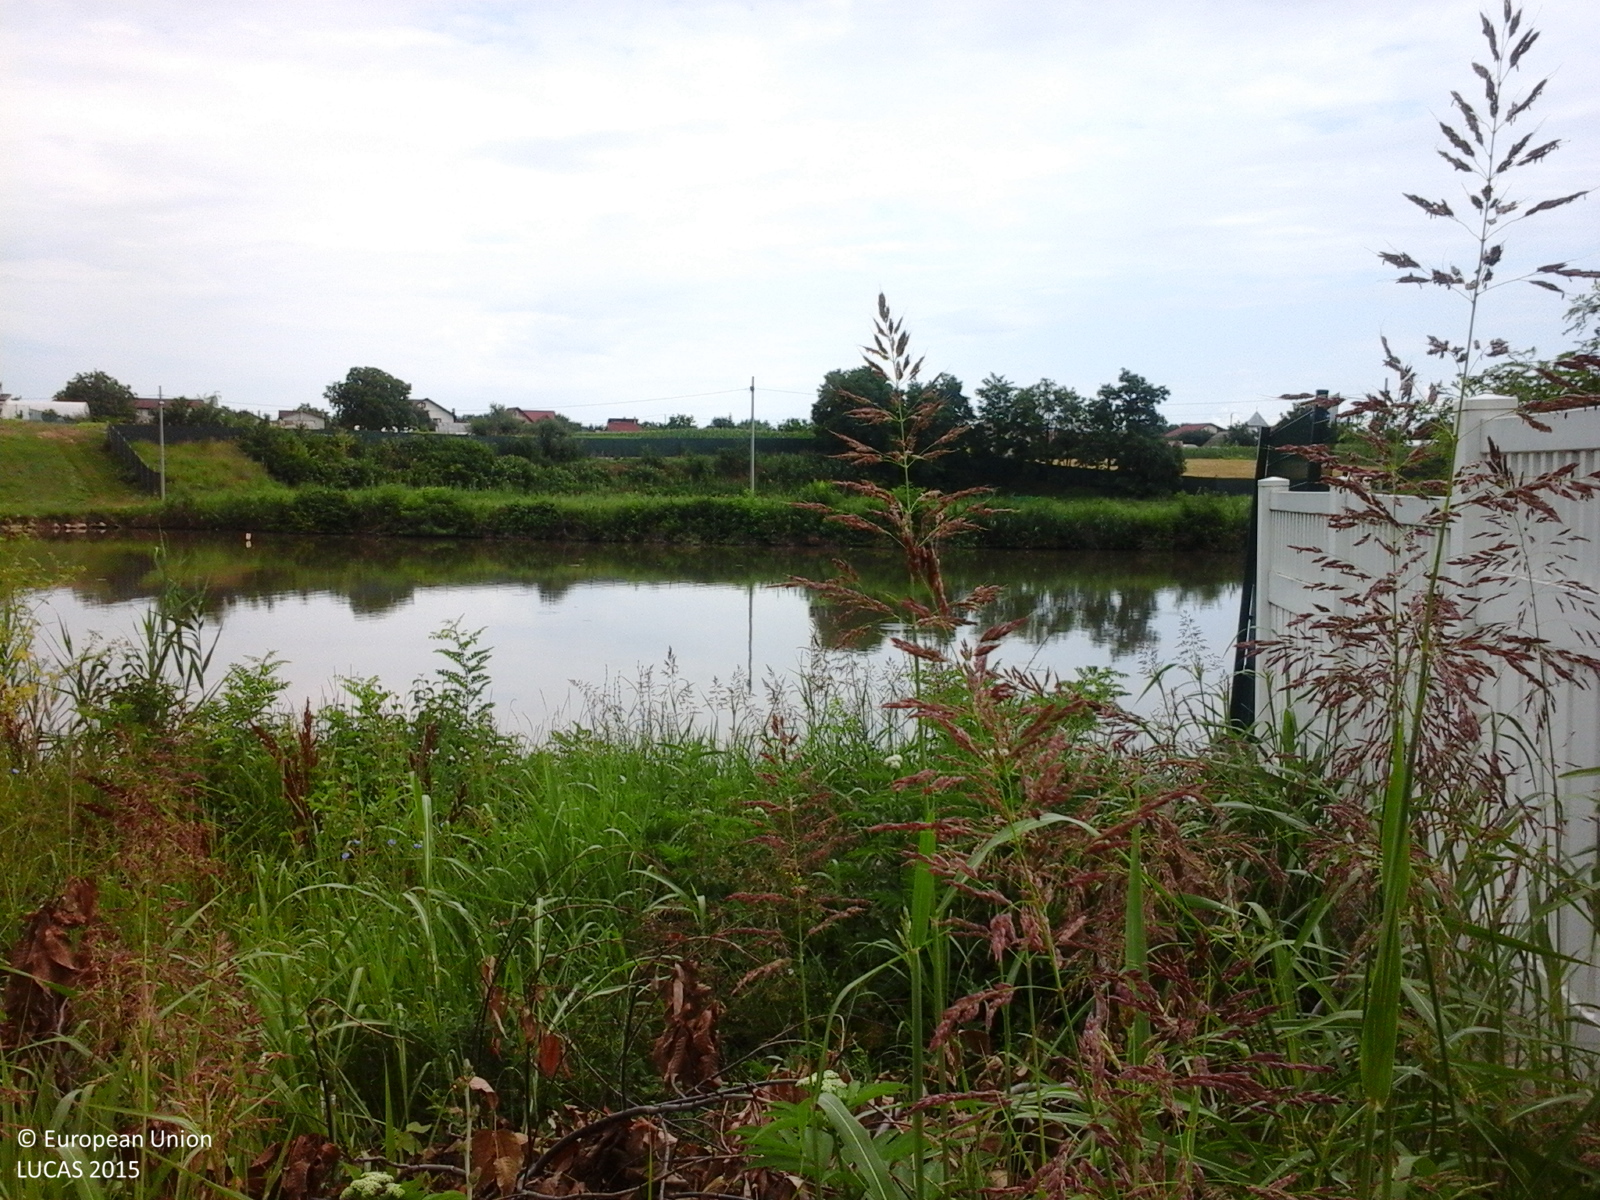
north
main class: Grassland
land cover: Grassland with sparse tree/shrub cover
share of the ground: > 75 %
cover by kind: herbaceous plants 95 %, coniferous forest trees 5 %
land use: Residential
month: June
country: RO
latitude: 44.6020
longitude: 26.0172
